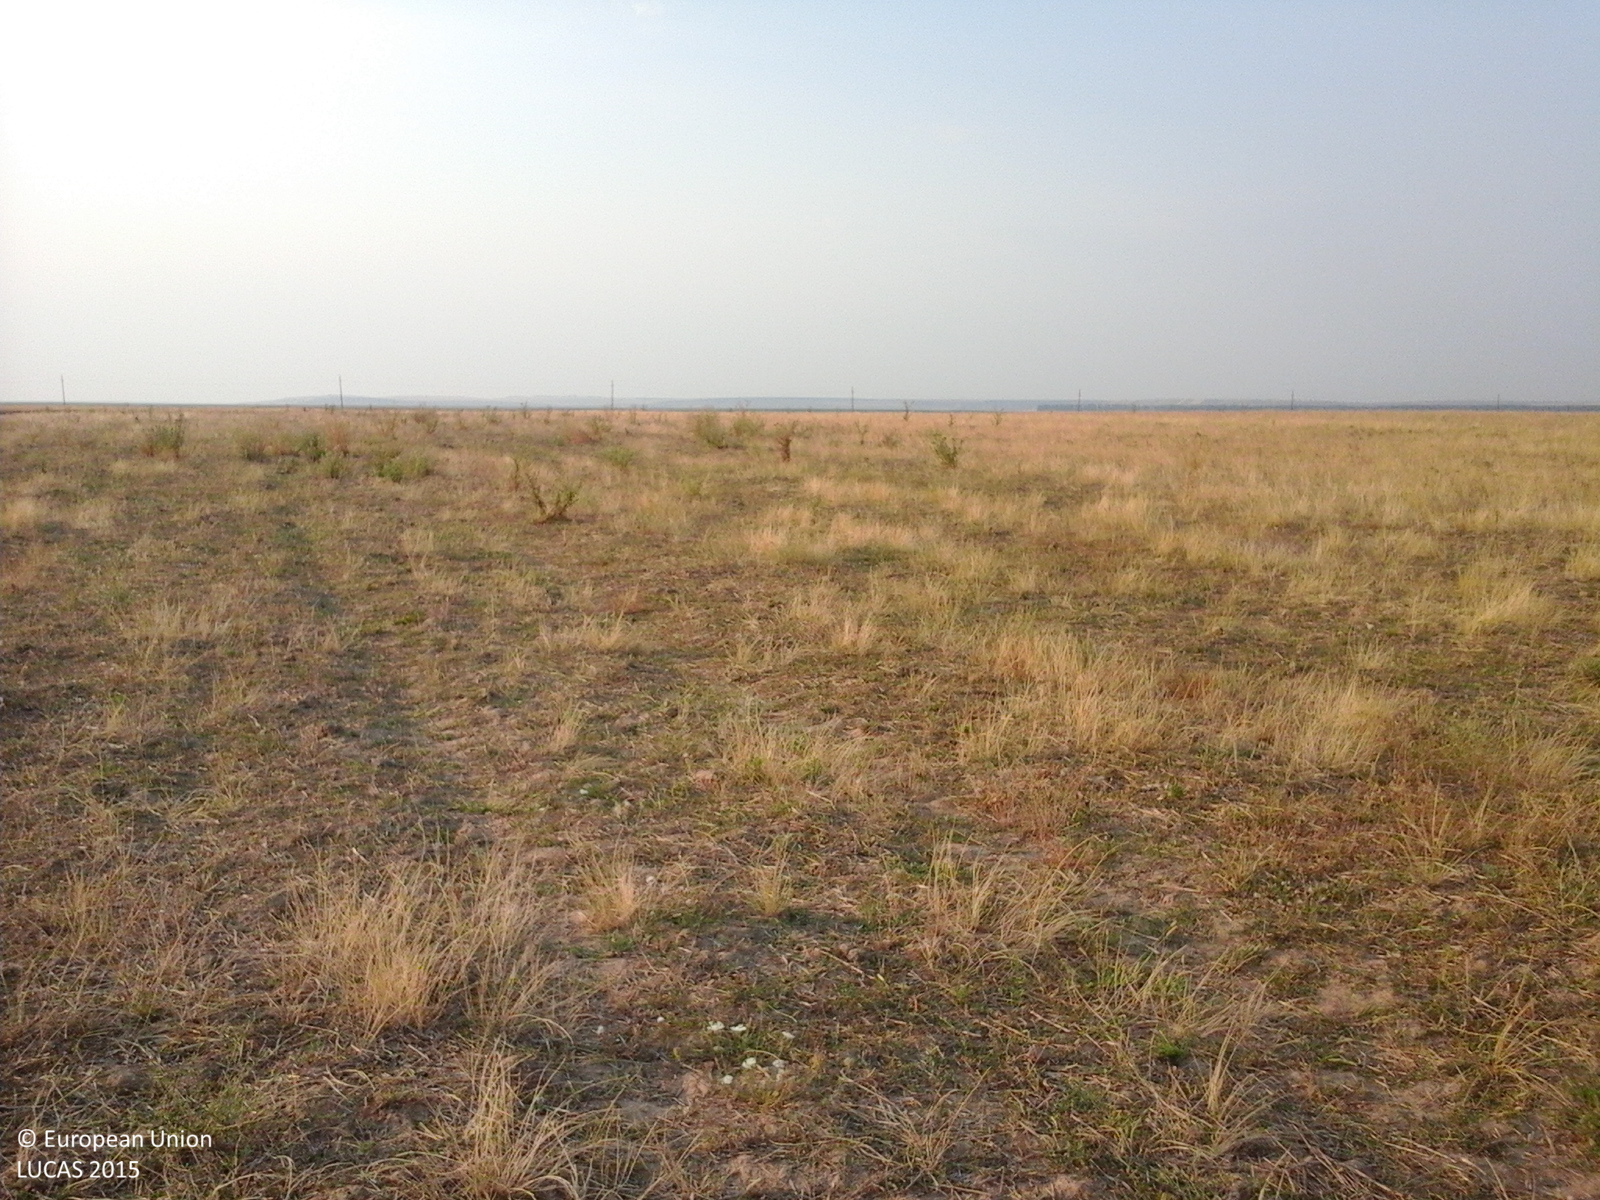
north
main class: Grassland
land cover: Spontaneously vegetated surfaces
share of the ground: > 75 %
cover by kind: herbaceous plants 100 %
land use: Fallow land
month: August
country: RO
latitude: 44.2819
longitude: 22.9620
